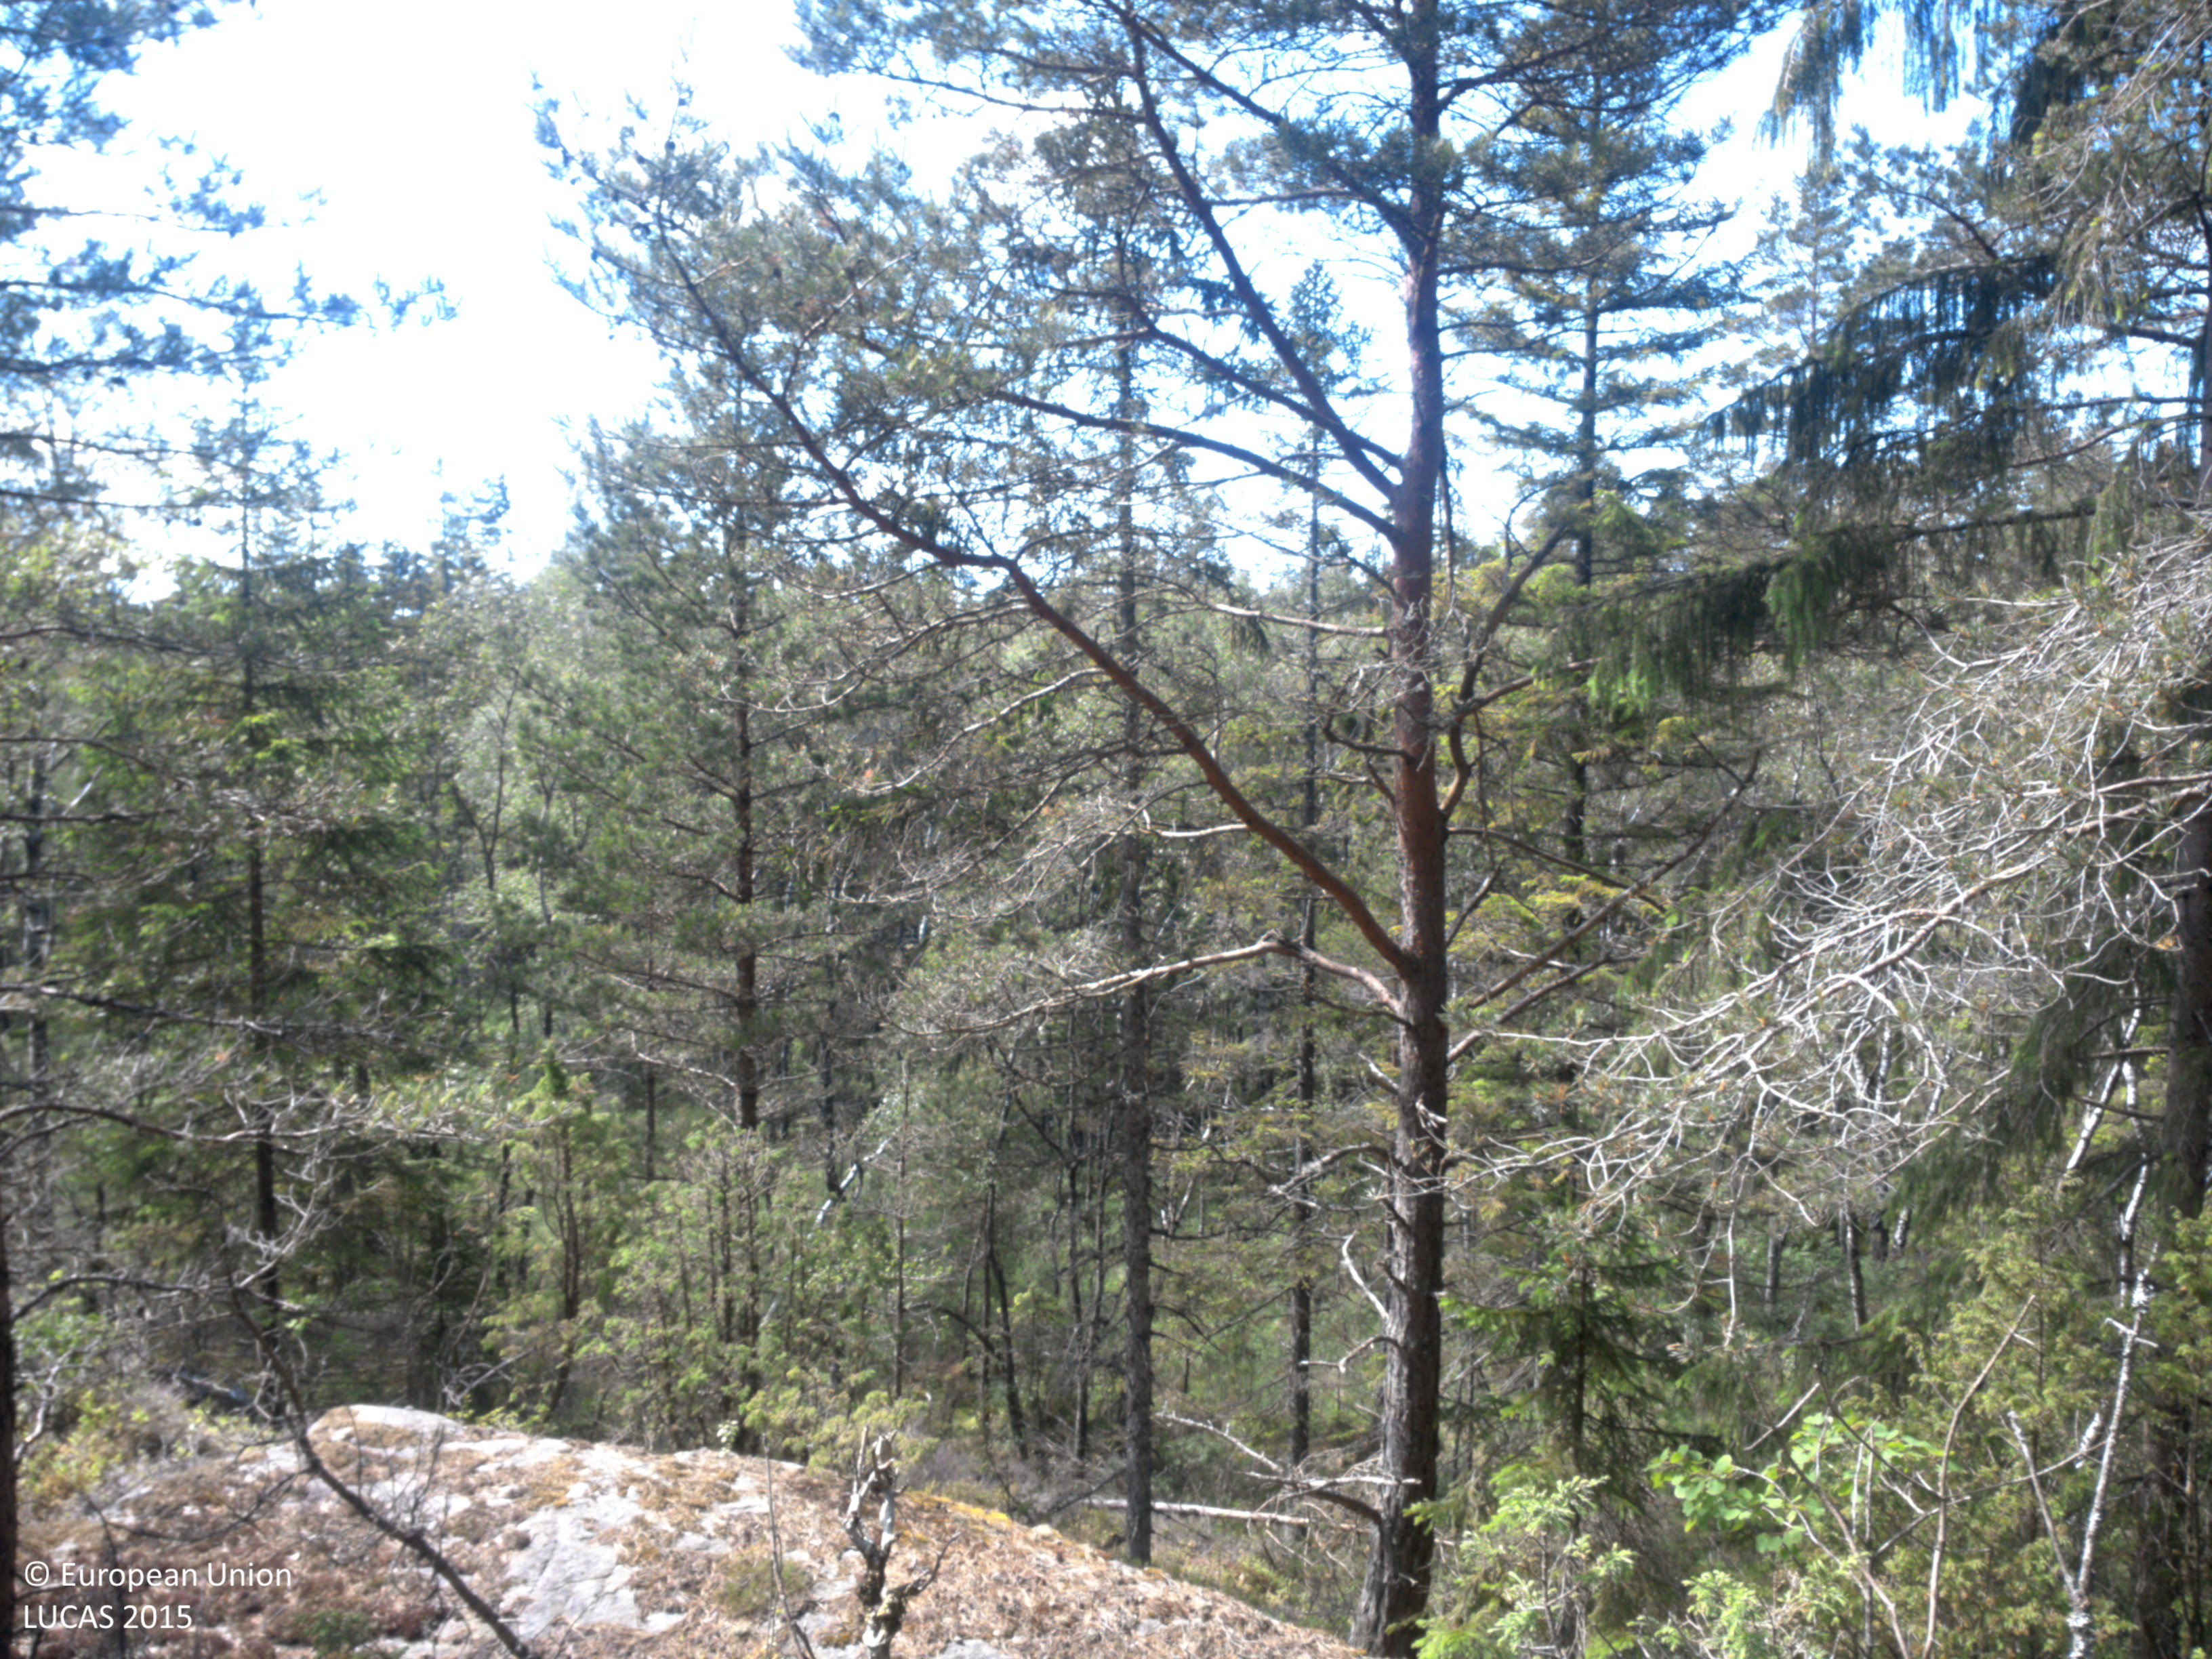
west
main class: Woodland
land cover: Pine dominated coniferous woodland
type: boreal forest
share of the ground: 50 - 75 %
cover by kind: coniferous forest trees 50 %, lichens and mosses 40 %, shrubs 10 %
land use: Forestry
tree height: > 5 m
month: June
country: SE
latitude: 58.6066
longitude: 11.5285
